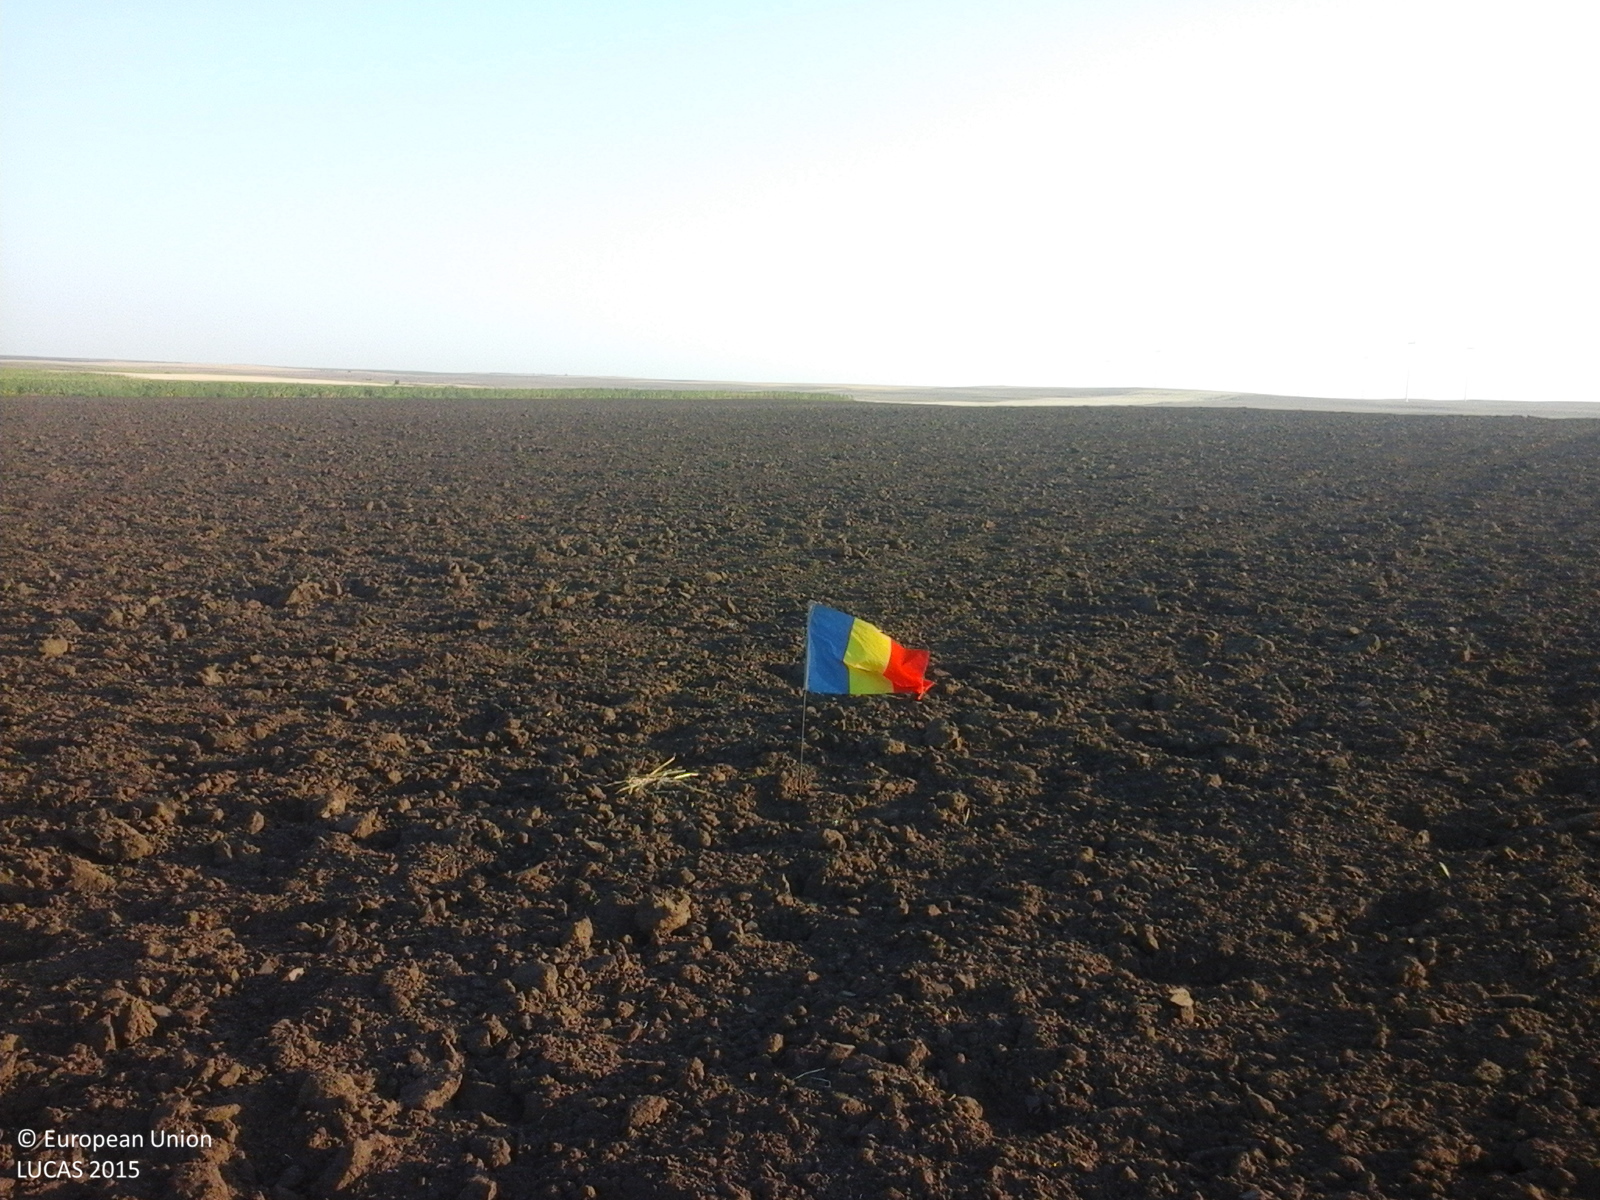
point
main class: Cropland
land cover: Common wheat
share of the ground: < 10 %
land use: Agriculture (excluding fallow land and kitchen gardens)
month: July
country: RO
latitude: 44.5630
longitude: 27.8176
